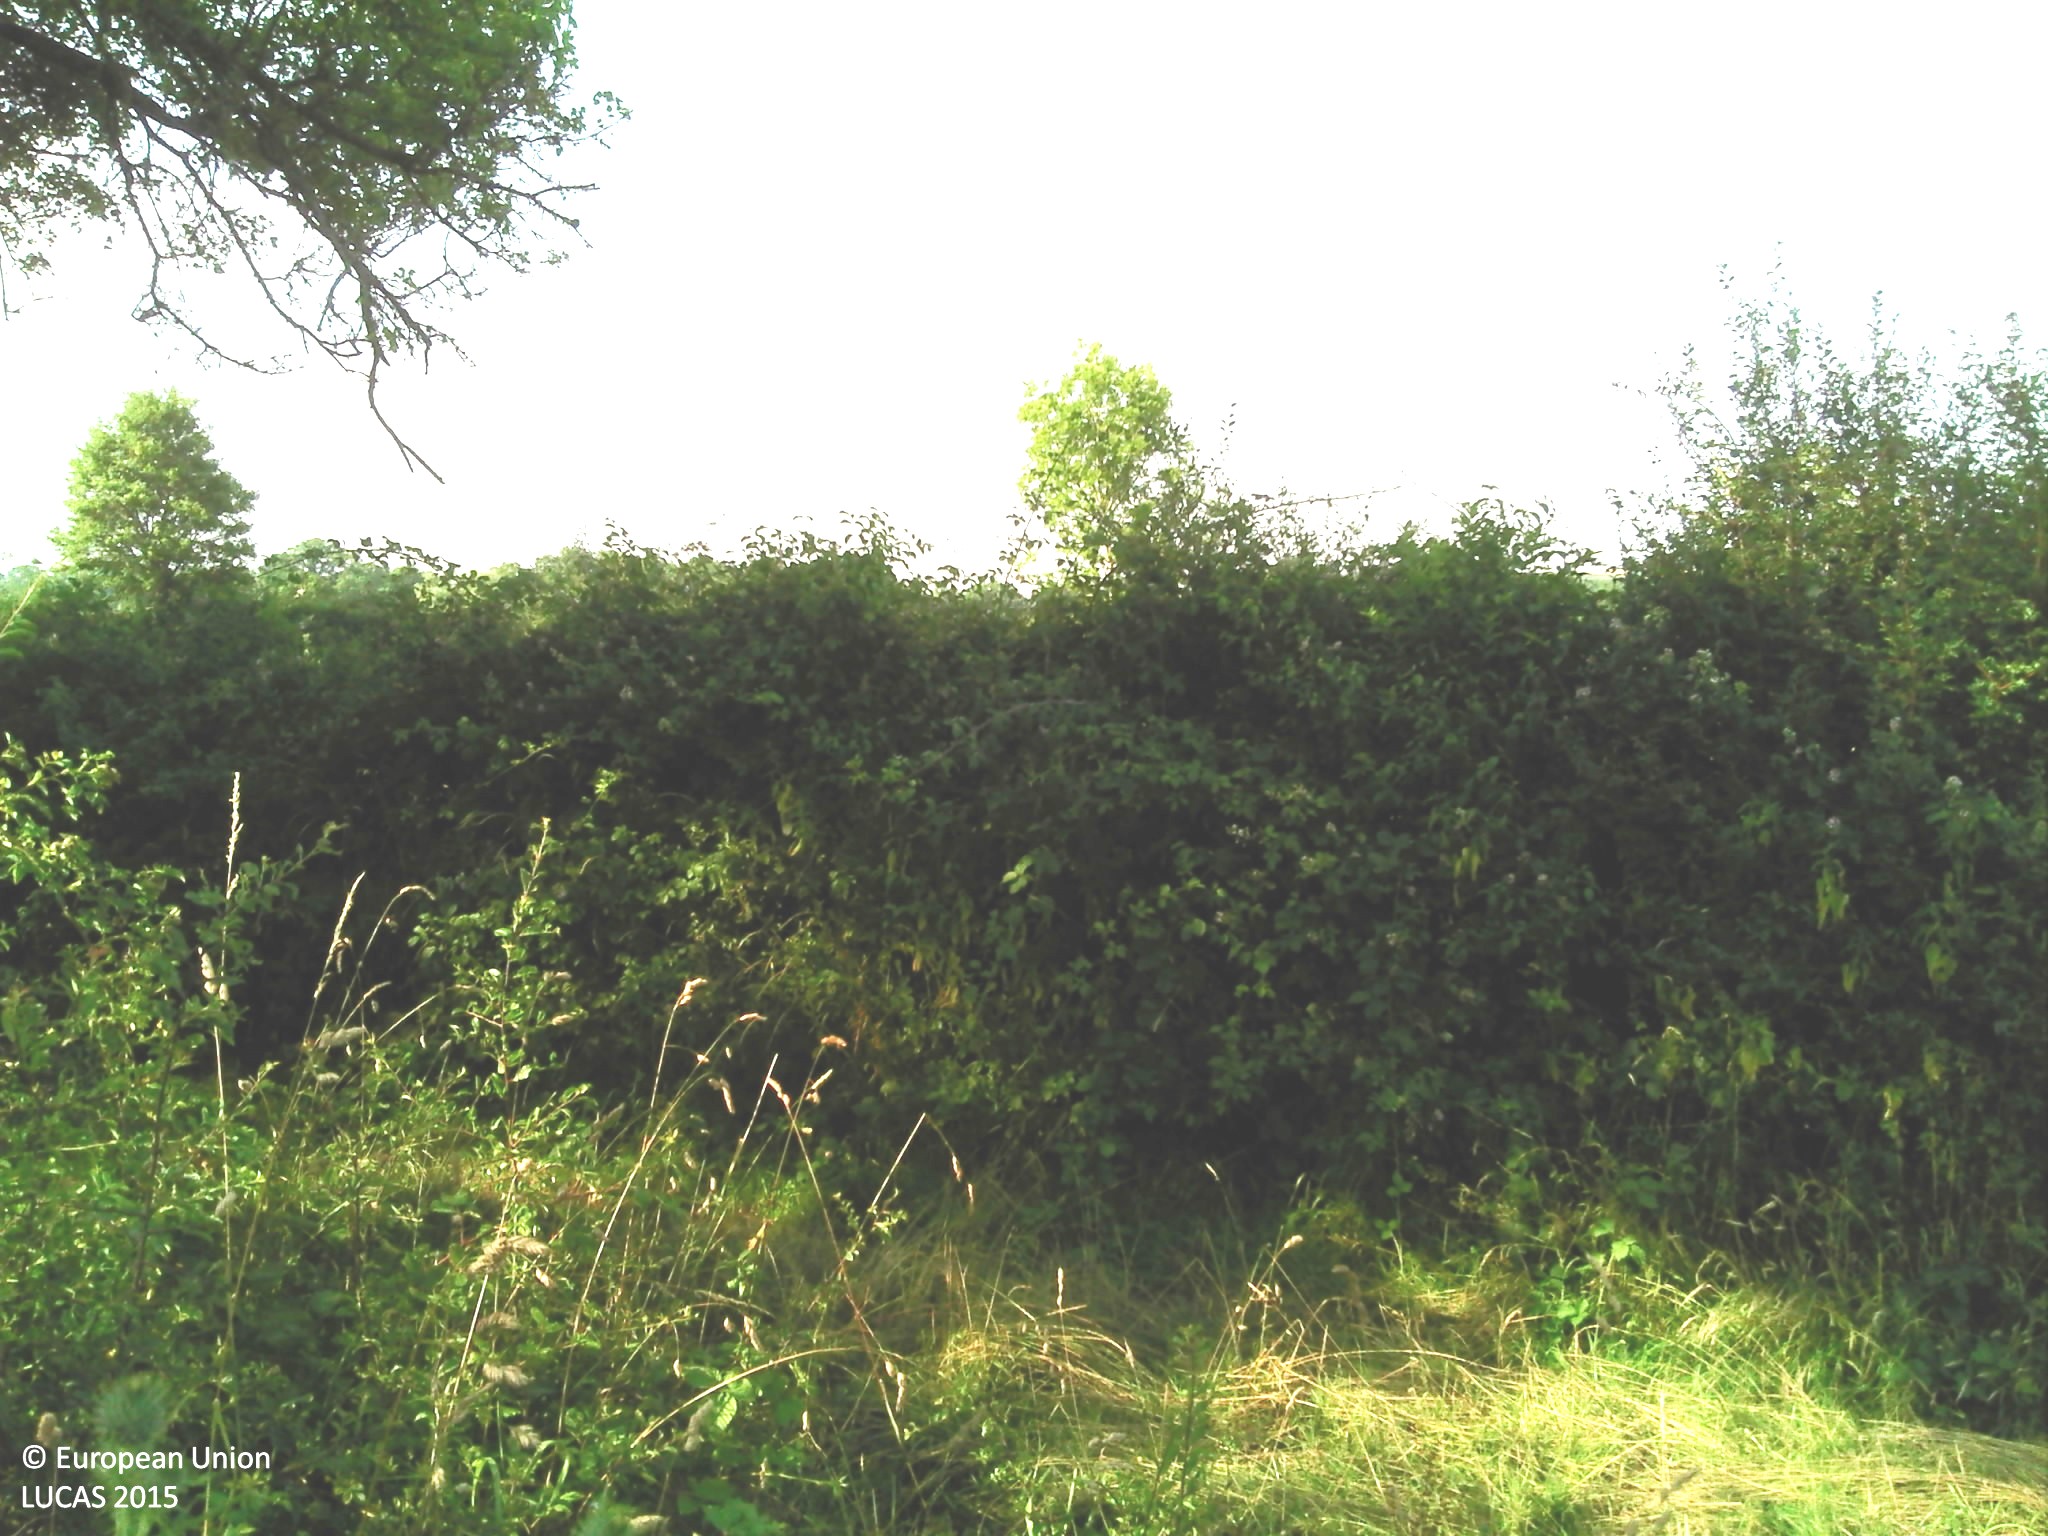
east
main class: Grassland
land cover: Grassland without tree/shrub cover
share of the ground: > 75 %
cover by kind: herbaceous plants 100 %
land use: Agriculture (excluding fallow land and kitchen gardens)
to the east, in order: Grassland without tree/shrub cover; Lines of trees; Fences; Abandoned hedges; Tracks; Fences; Abandoned hedges; Grassland without tree/shrub cover
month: July
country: FR
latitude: 47.3517
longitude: 3.6029
